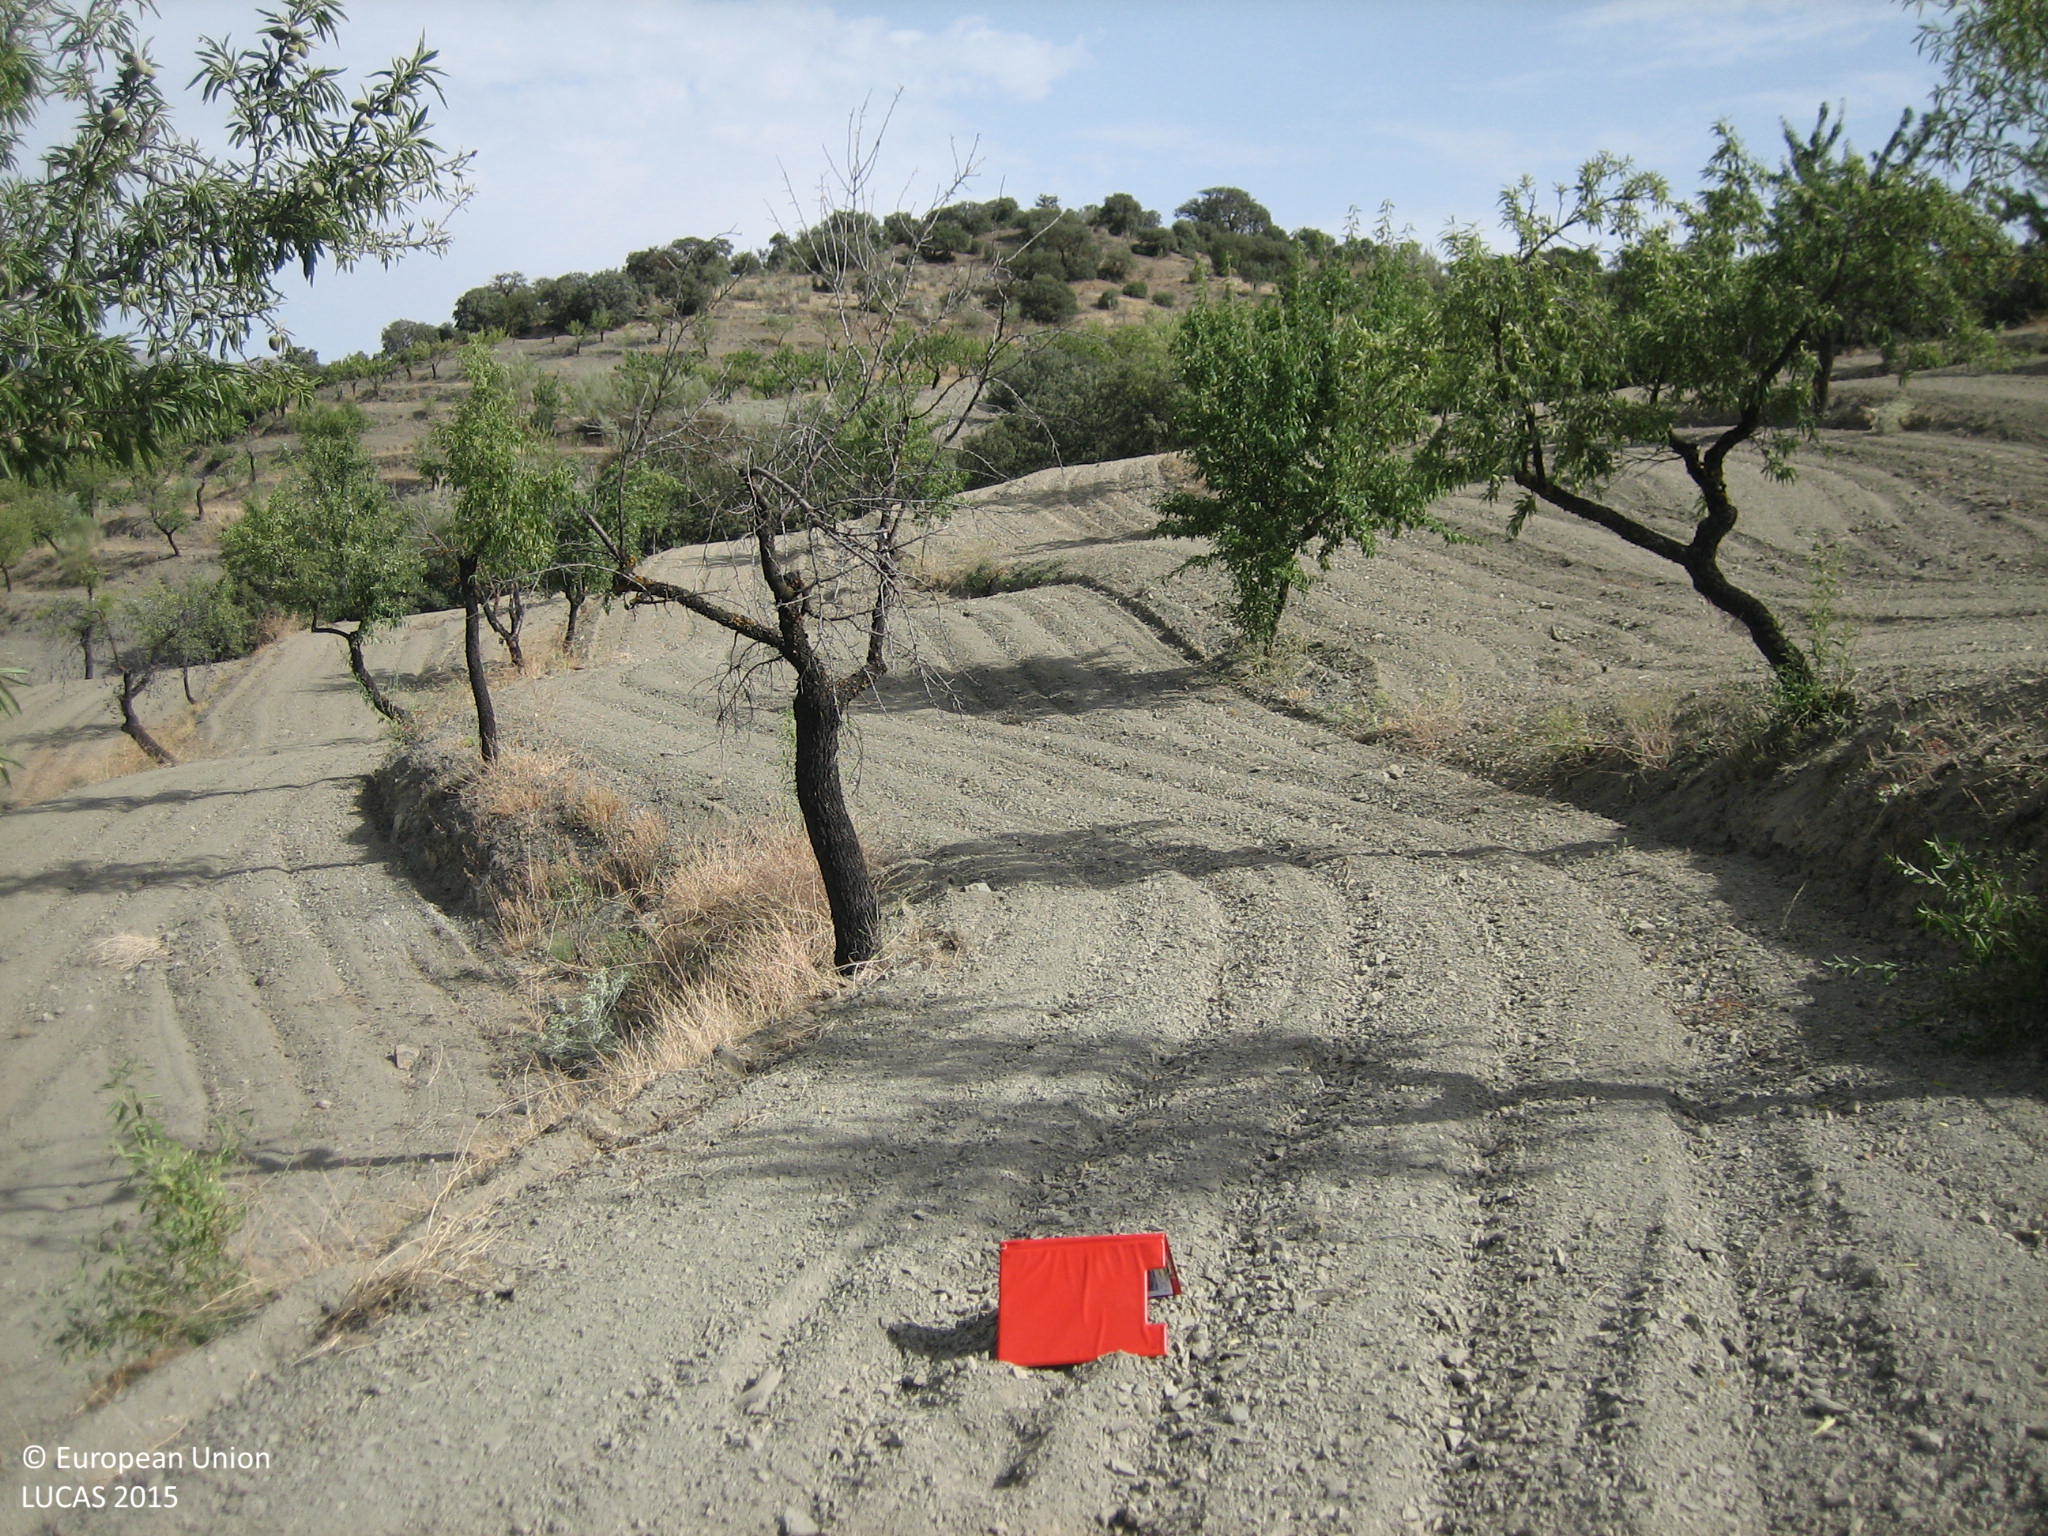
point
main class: Cropland
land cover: Nuts trees
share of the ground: 10 - 25 %
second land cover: Other bare soil
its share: > 75 %
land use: Agriculture (excluding fallow land and kitchen gardens)
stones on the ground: < 10 %
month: July
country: ES
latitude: 37.5398
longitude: -2.2409
